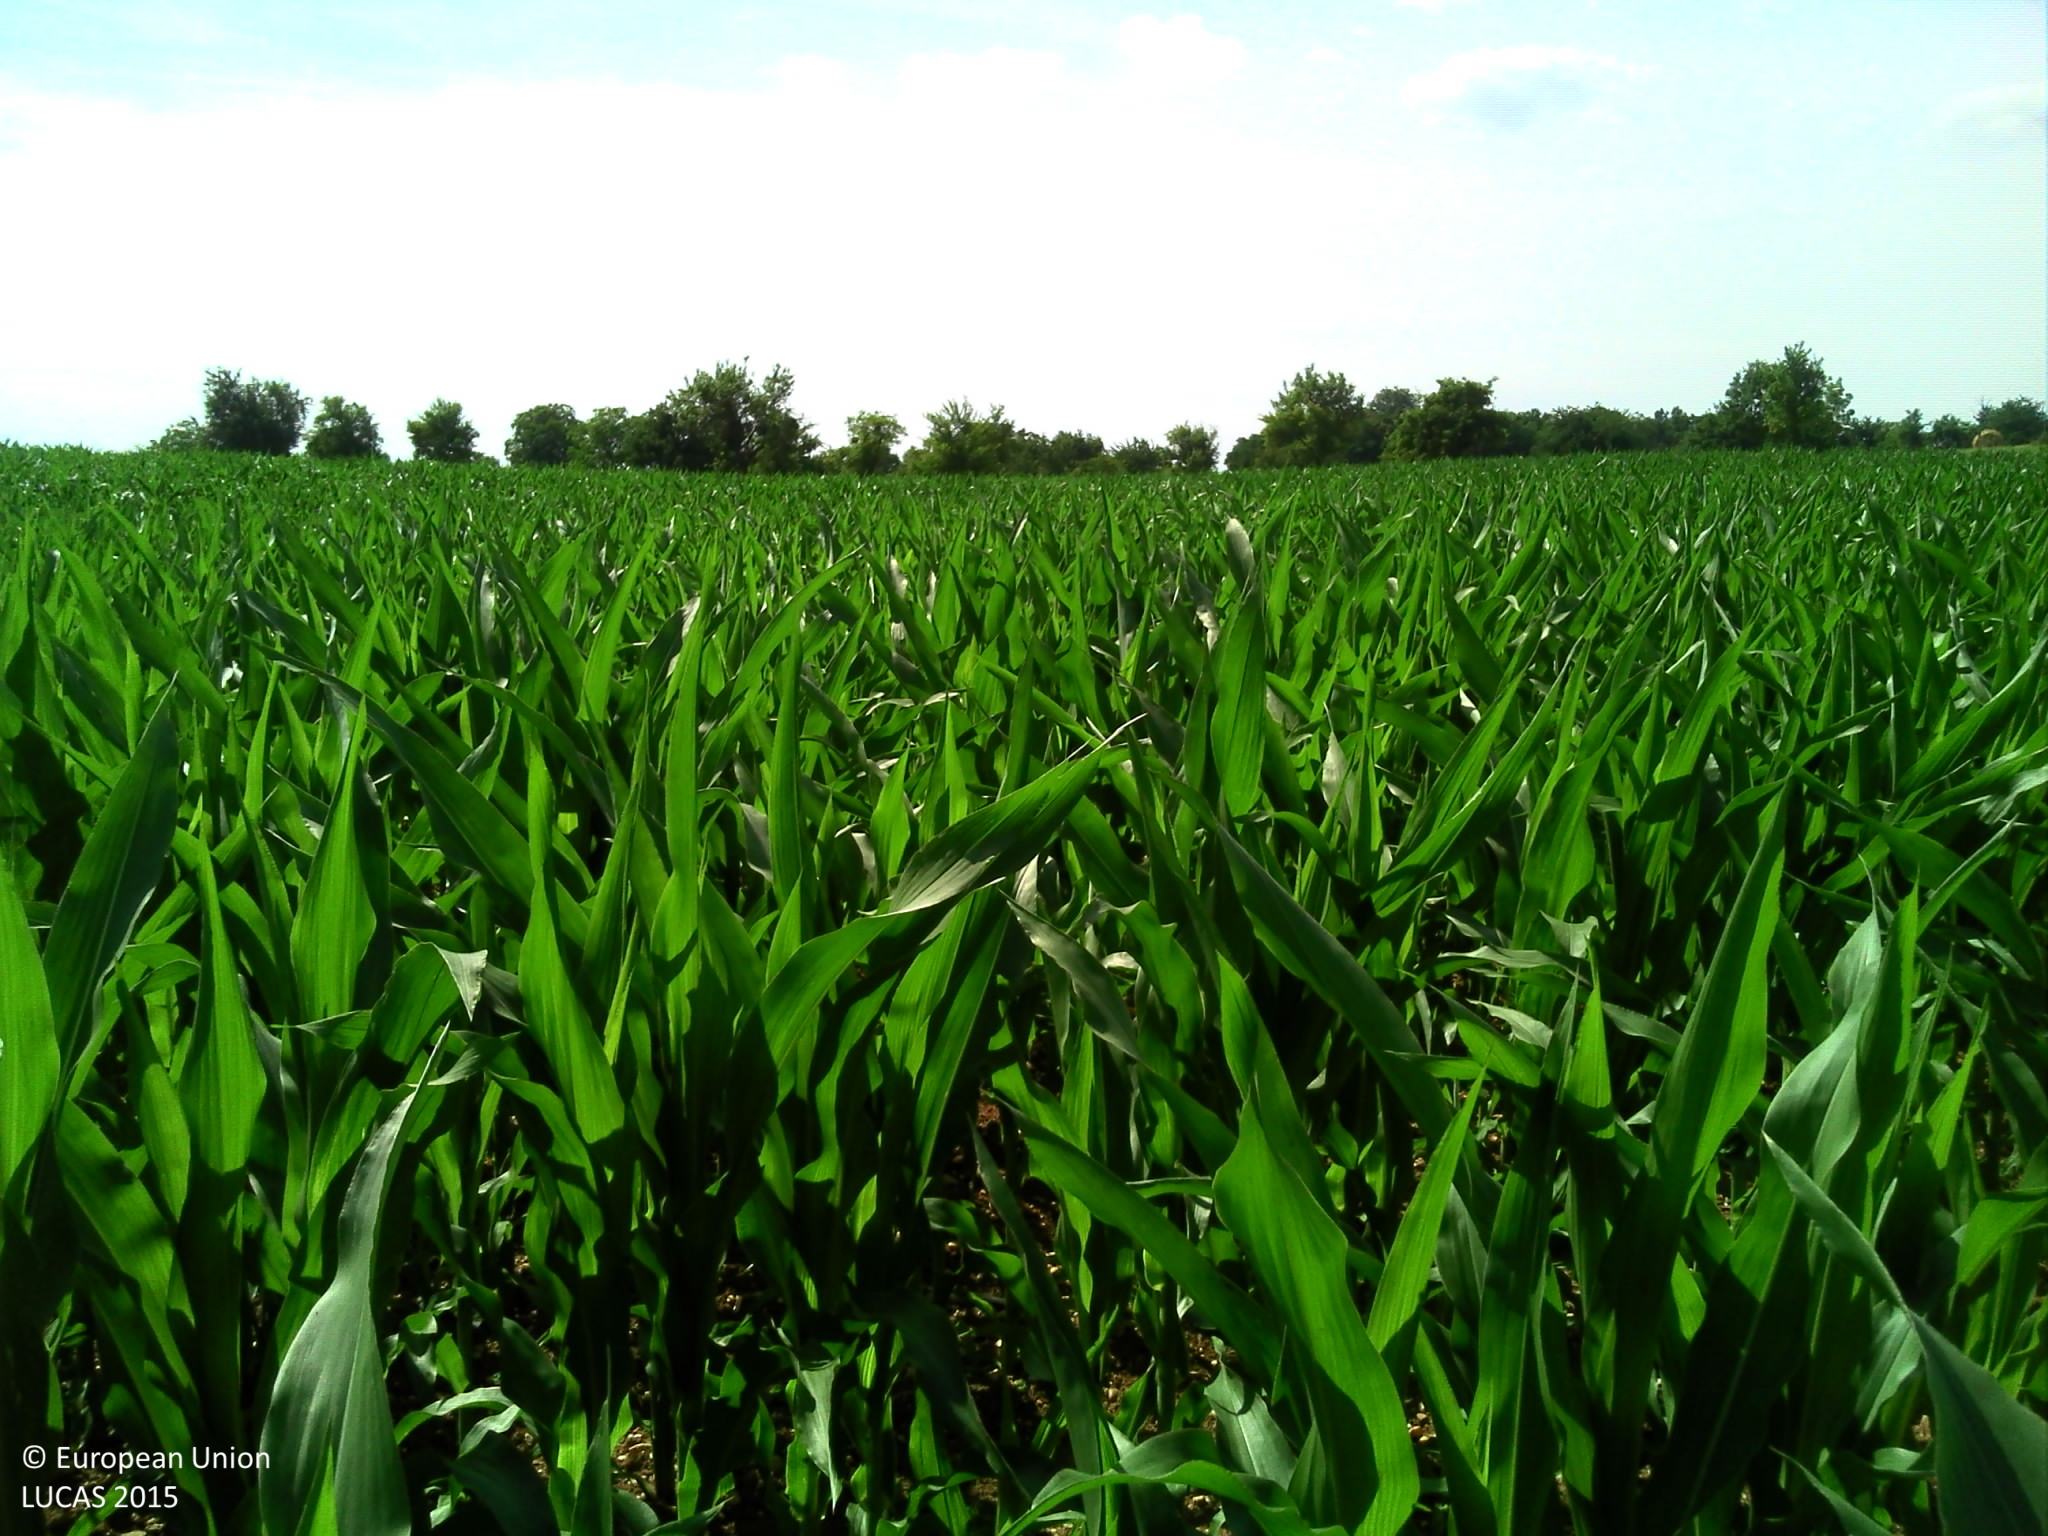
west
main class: Cropland
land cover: Maize
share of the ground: 50 - 75 %
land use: Agriculture (excluding fallow land and kitchen gardens)
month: June
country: FR
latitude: 48.7535
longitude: 7.5116
